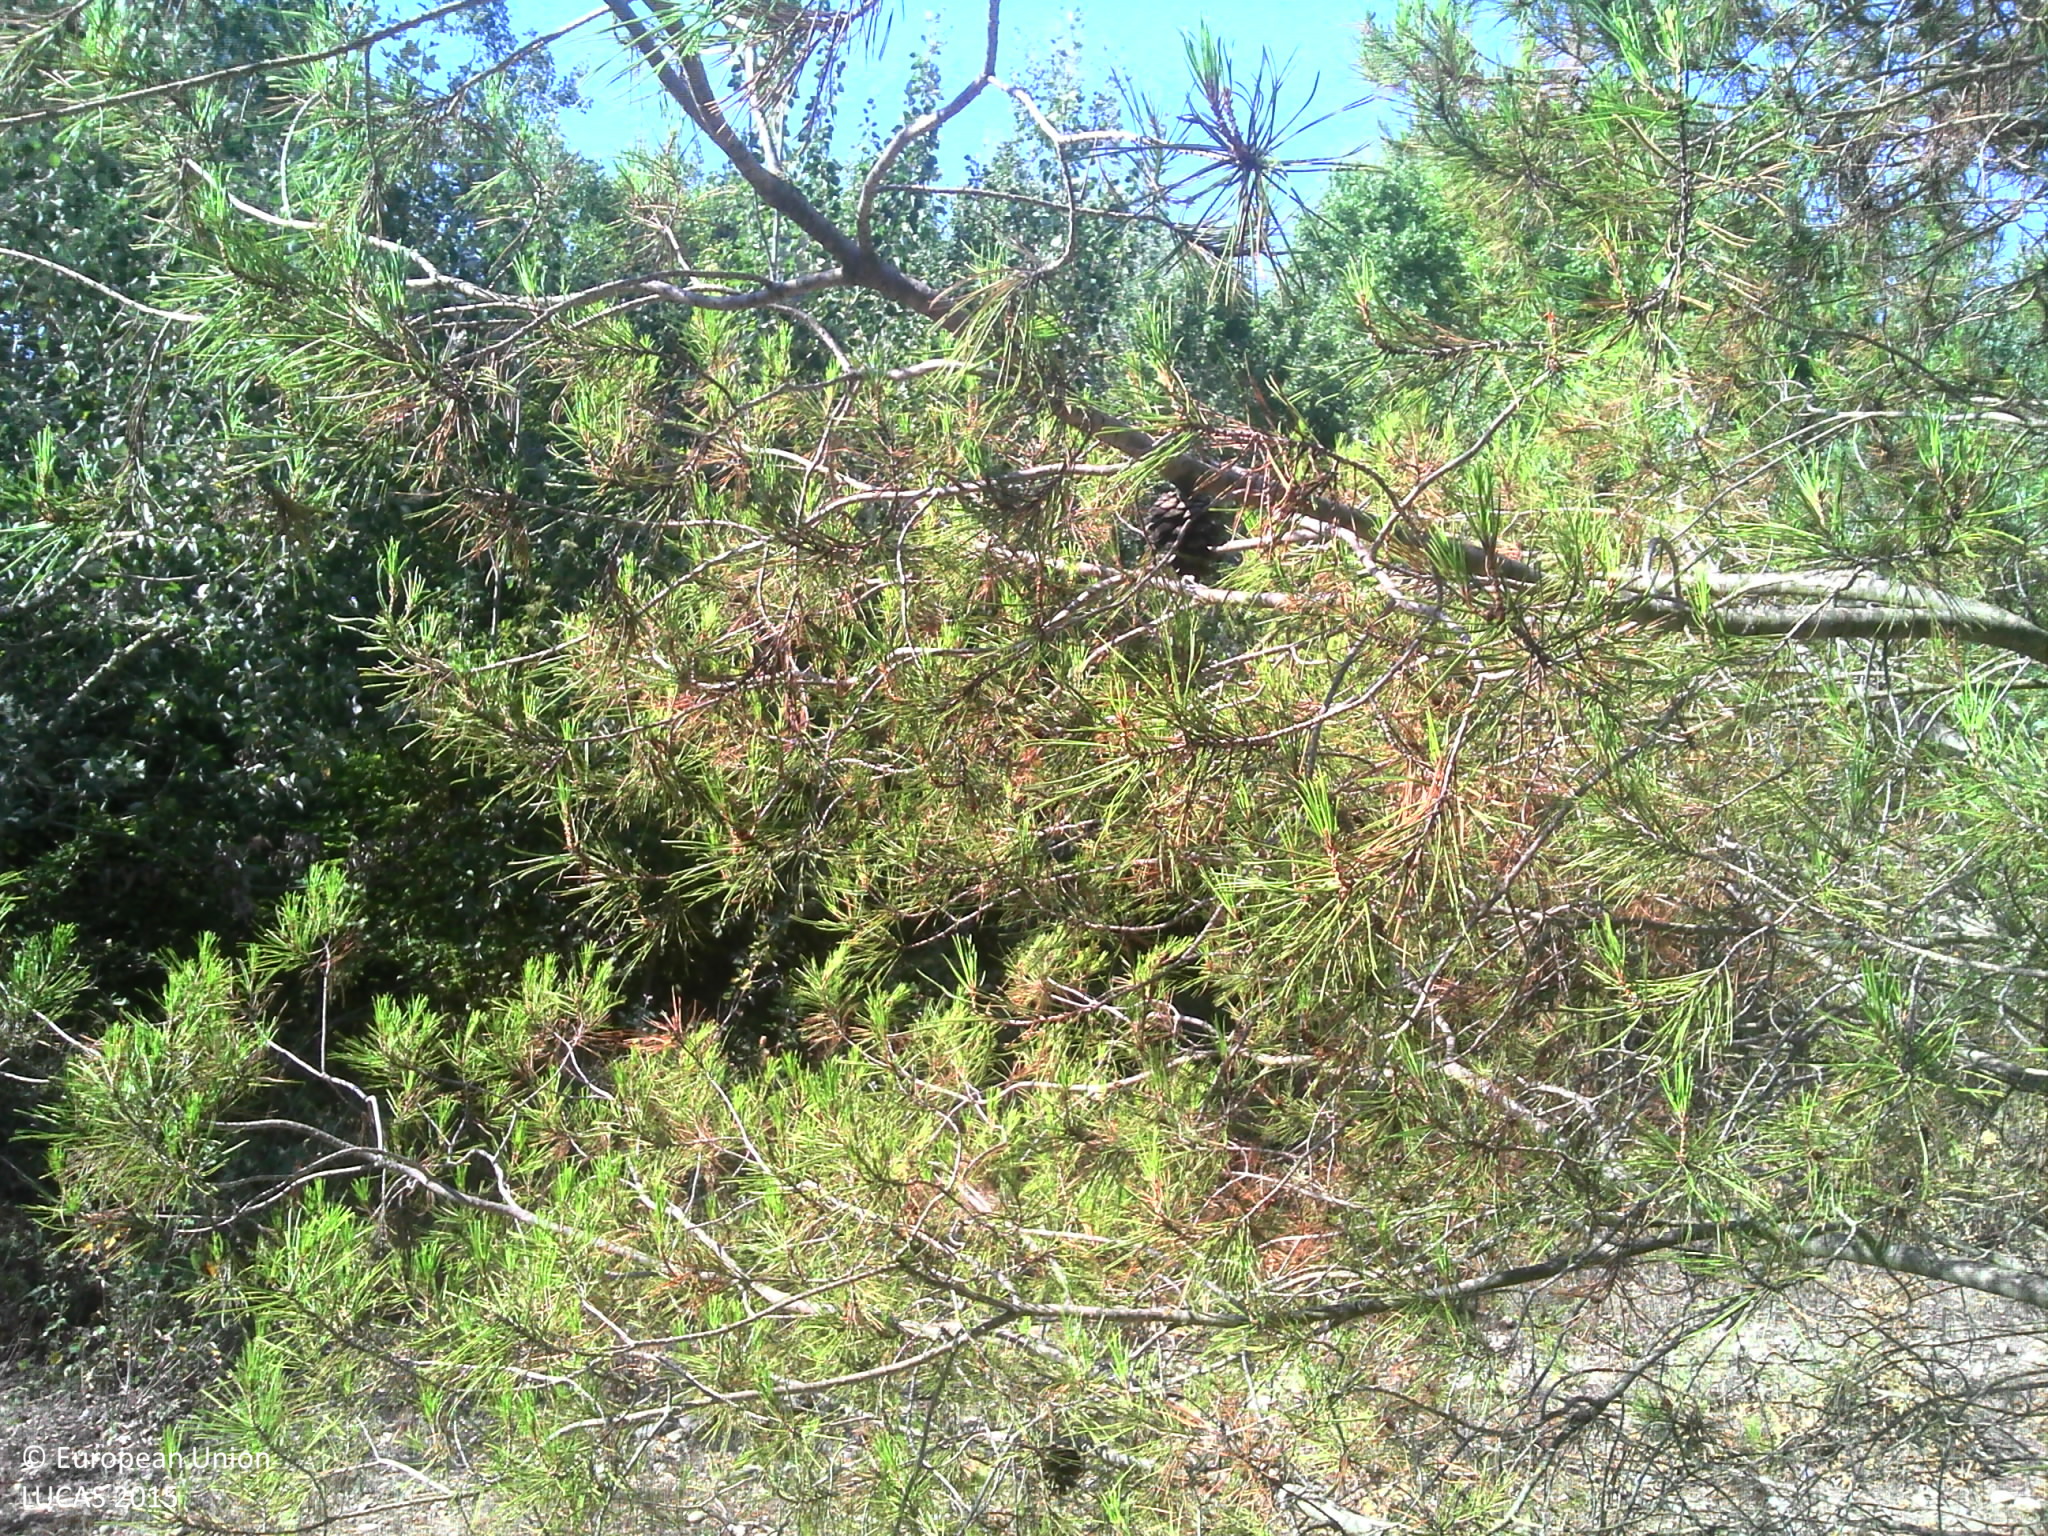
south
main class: Woodland
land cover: Broadleaved woodland
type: thermophilous deciduous forest
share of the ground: > 75 %
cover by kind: broadleaved forest trees 60 %, unconsolidated bare surface 20 %, shrubs 10 %, coniferous forest trees 5 %, herbaceous plants 5 %
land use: Semi-natural and natural areas not in use
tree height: > 5 m
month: August
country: FR
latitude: 43.6593
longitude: 5.5576
